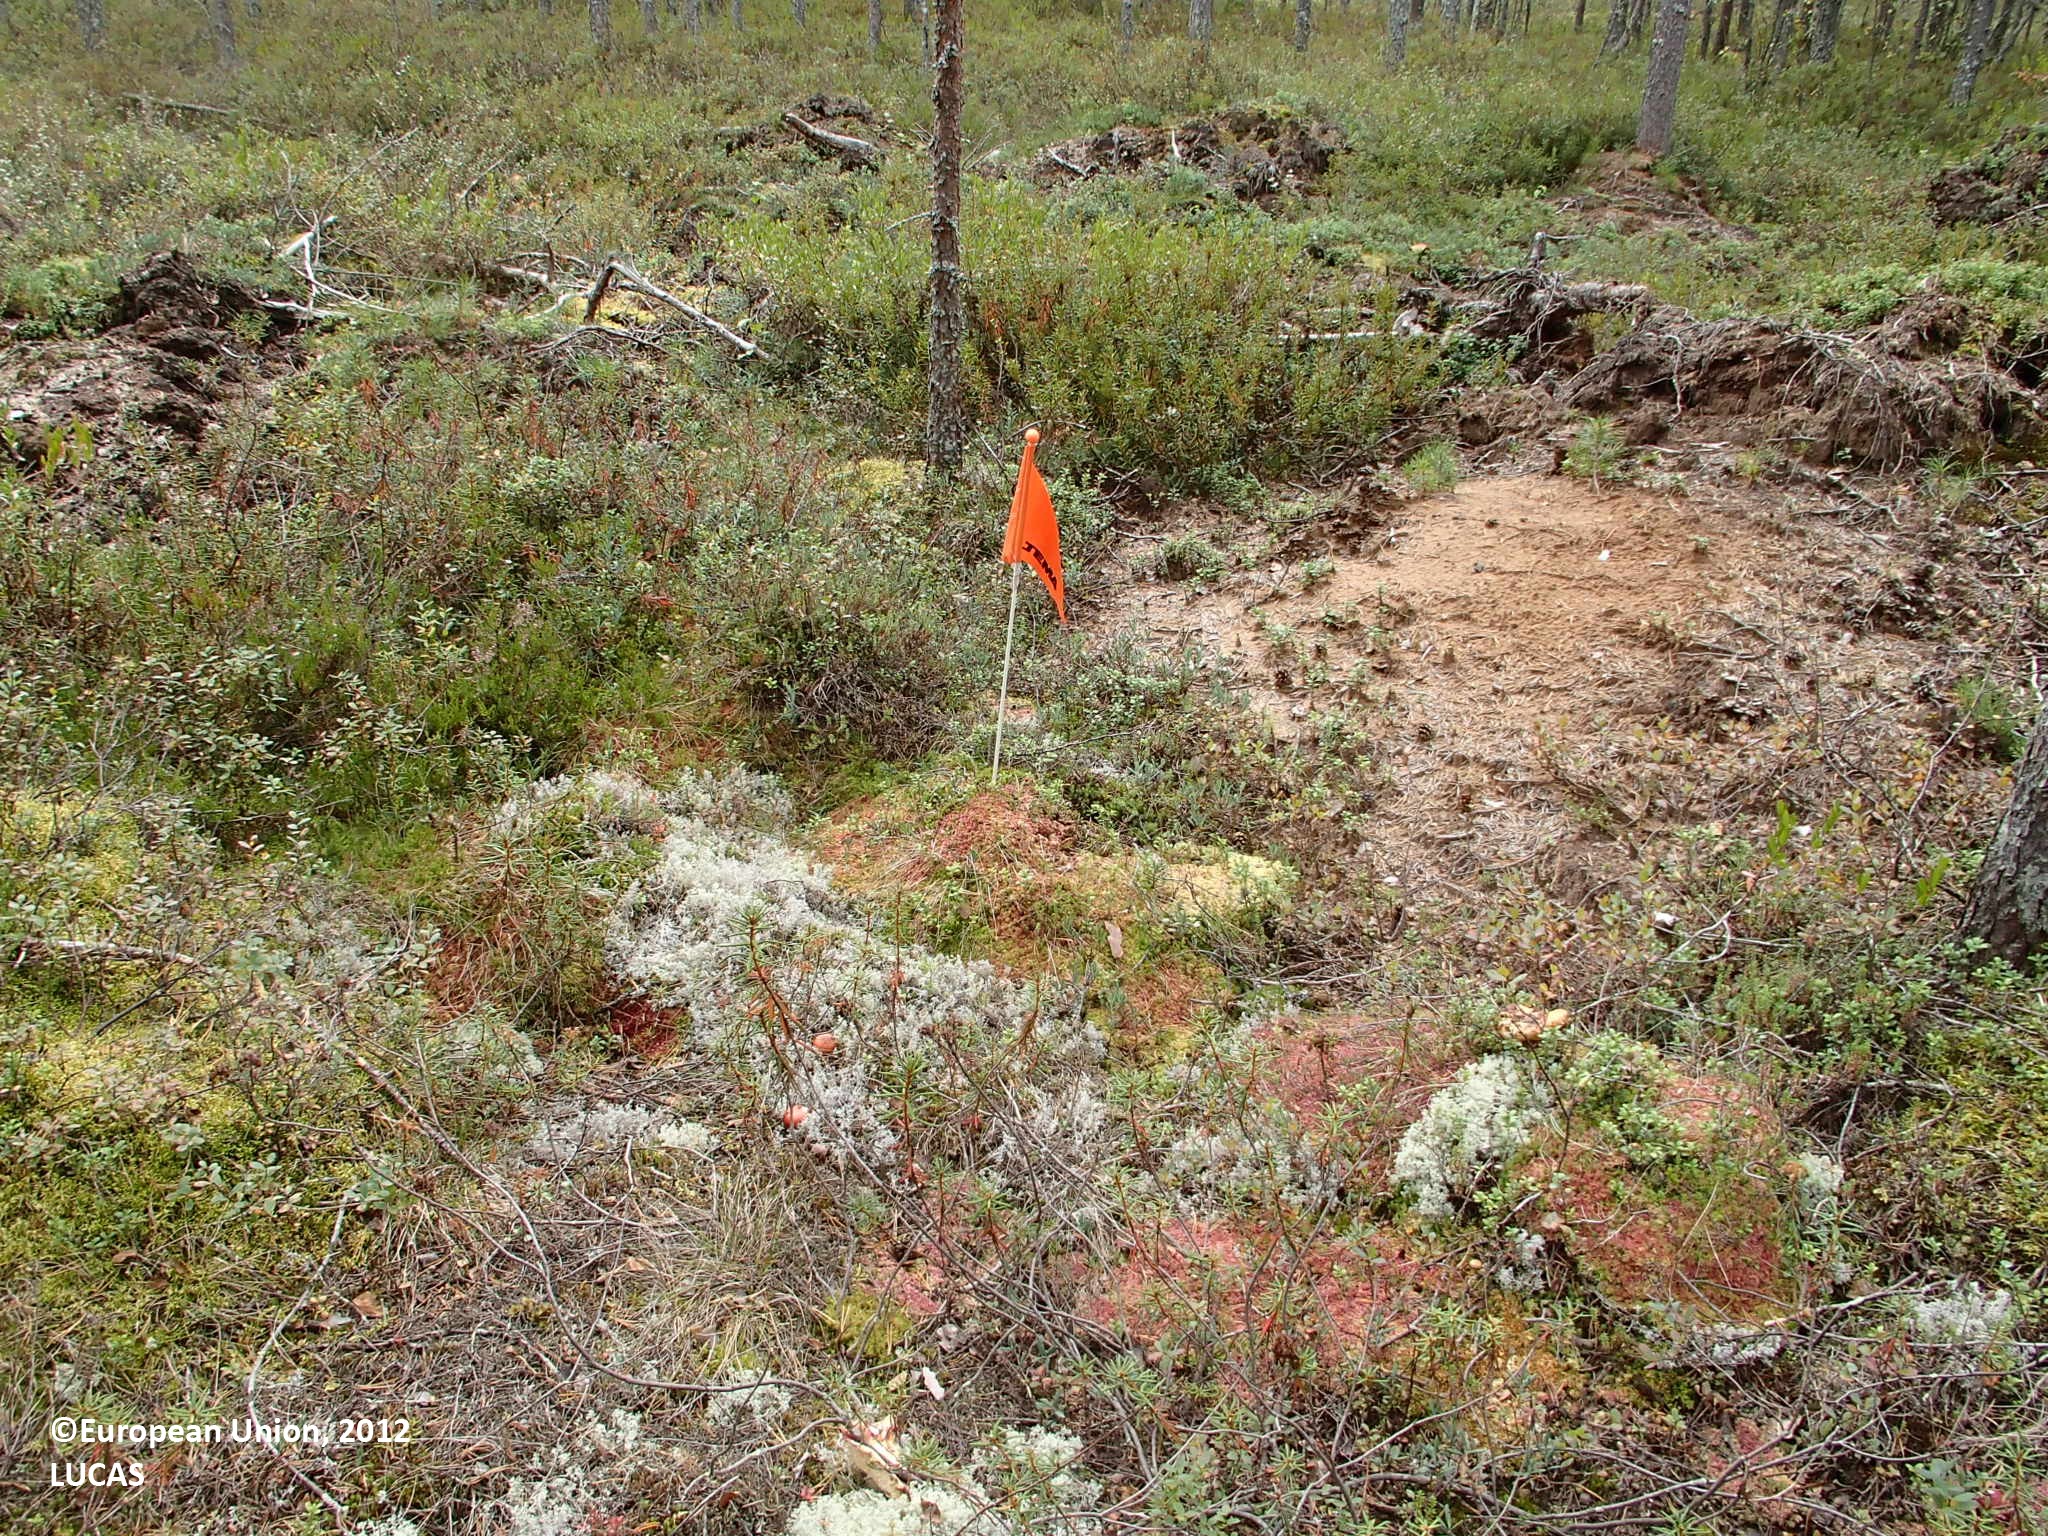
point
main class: Woodland
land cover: Pine dominated coniferous woodland
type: boreal forest
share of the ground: 50 - 75 %
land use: Forestry
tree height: > 5 m
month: September
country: FI
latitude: 63.7998
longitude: 26.0058
